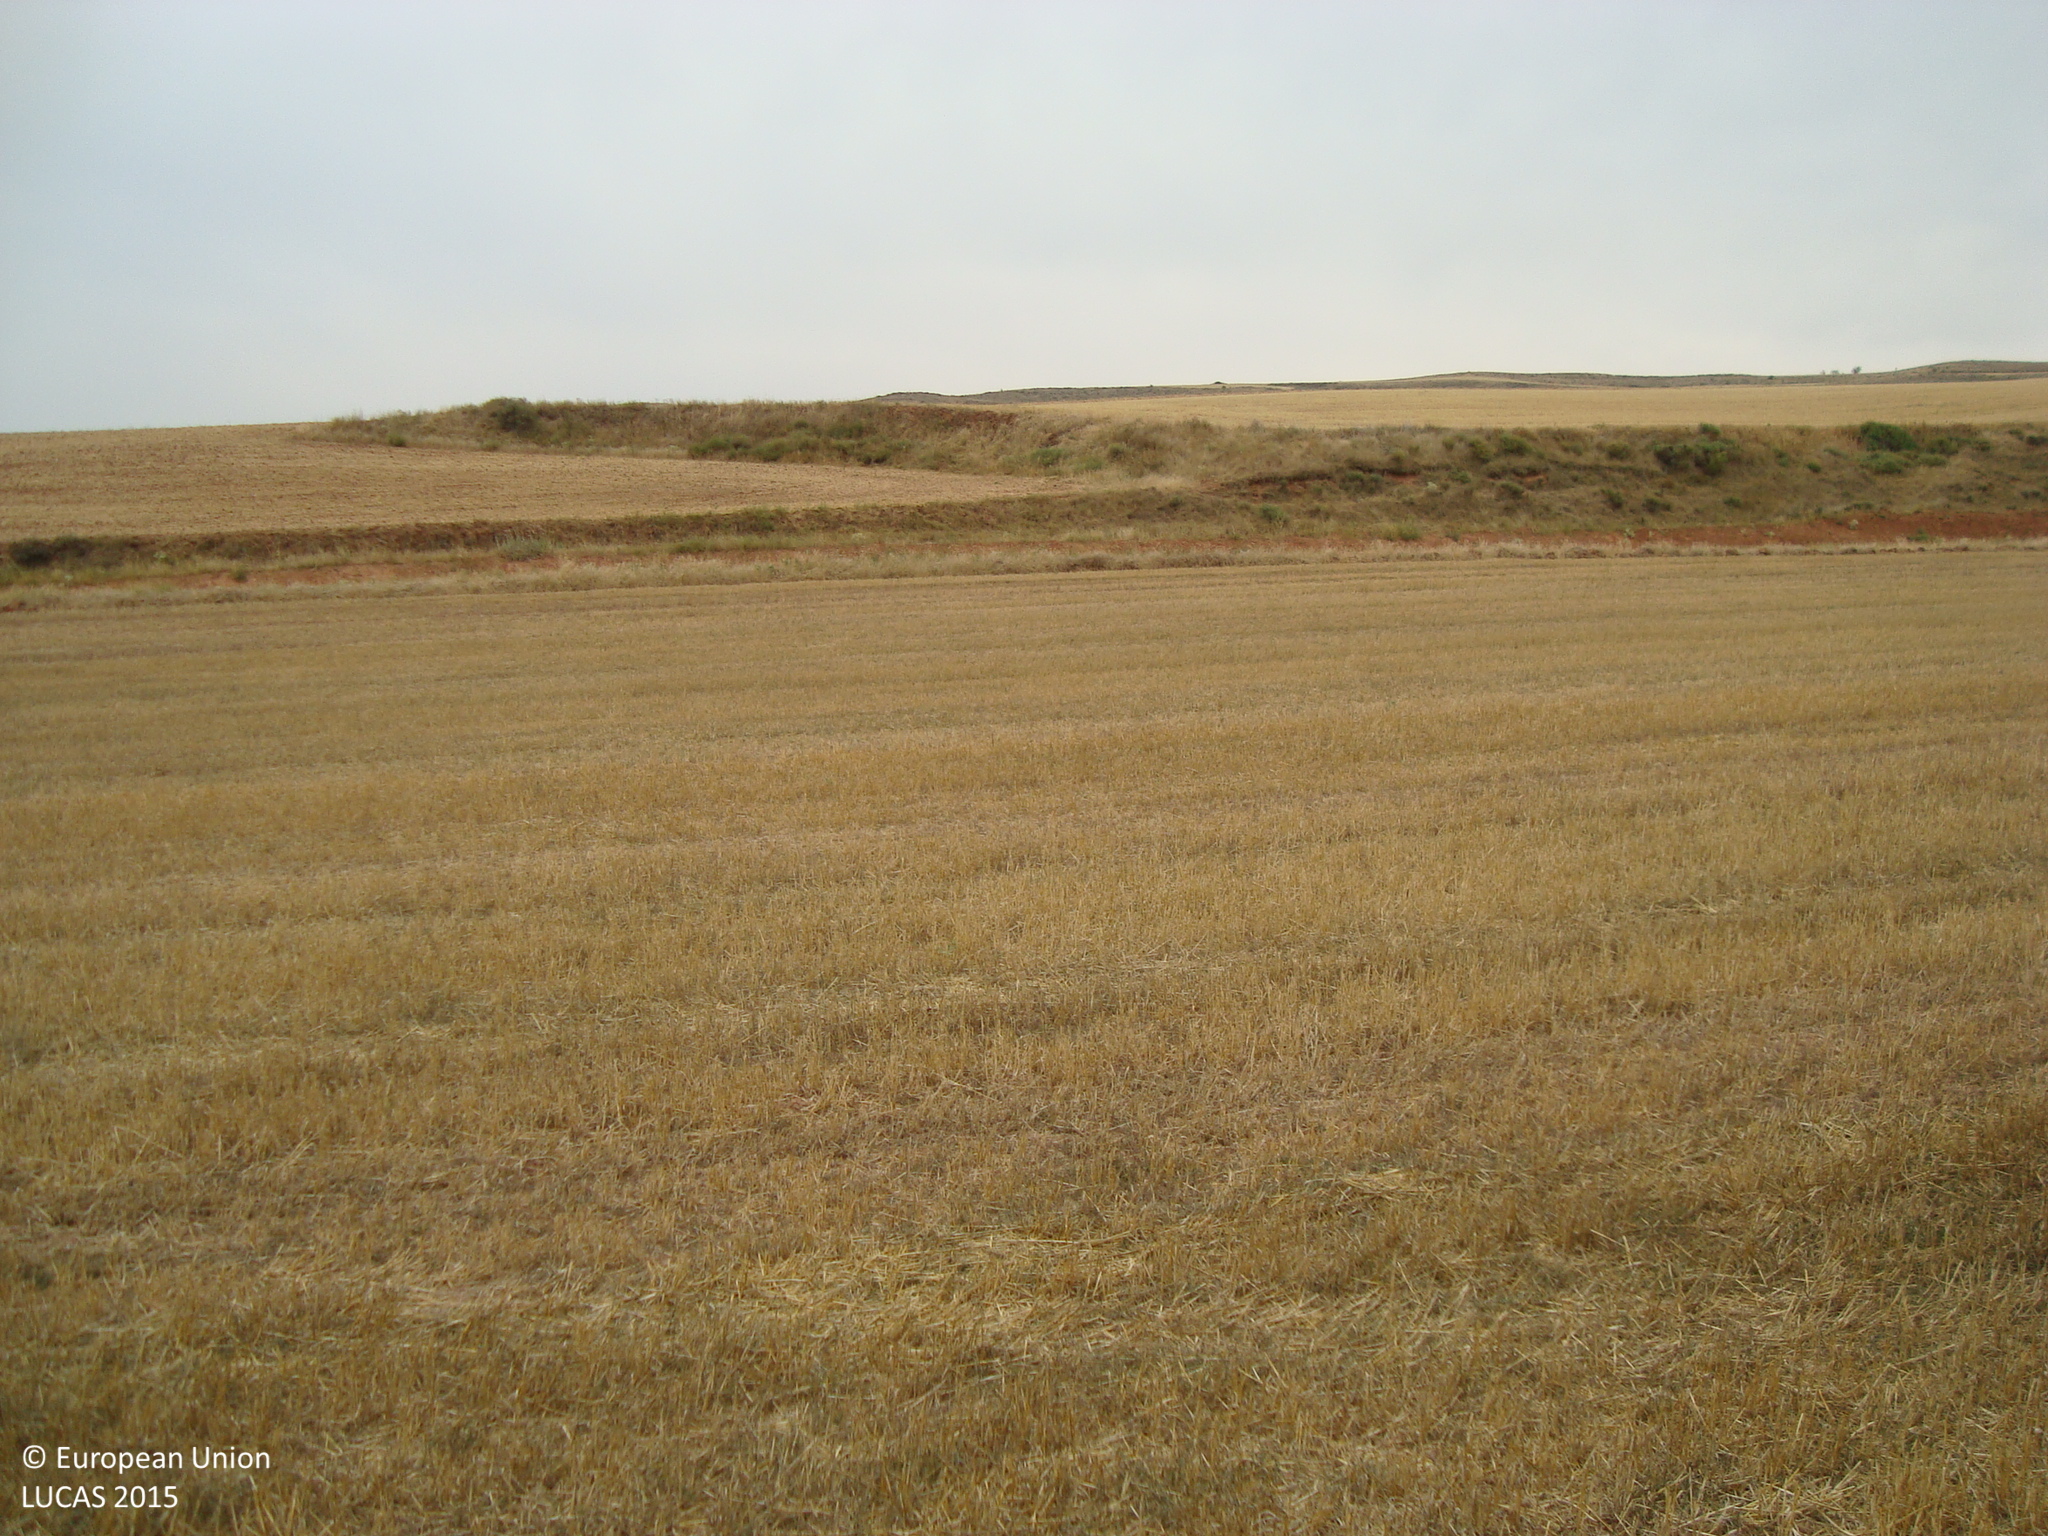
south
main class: Cropland
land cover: Barley
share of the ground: > 75 %
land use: Agriculture (excluding fallow land and kitchen gardens)
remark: Harvested field
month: August
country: ES
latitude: 42.1743
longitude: -3.9725
